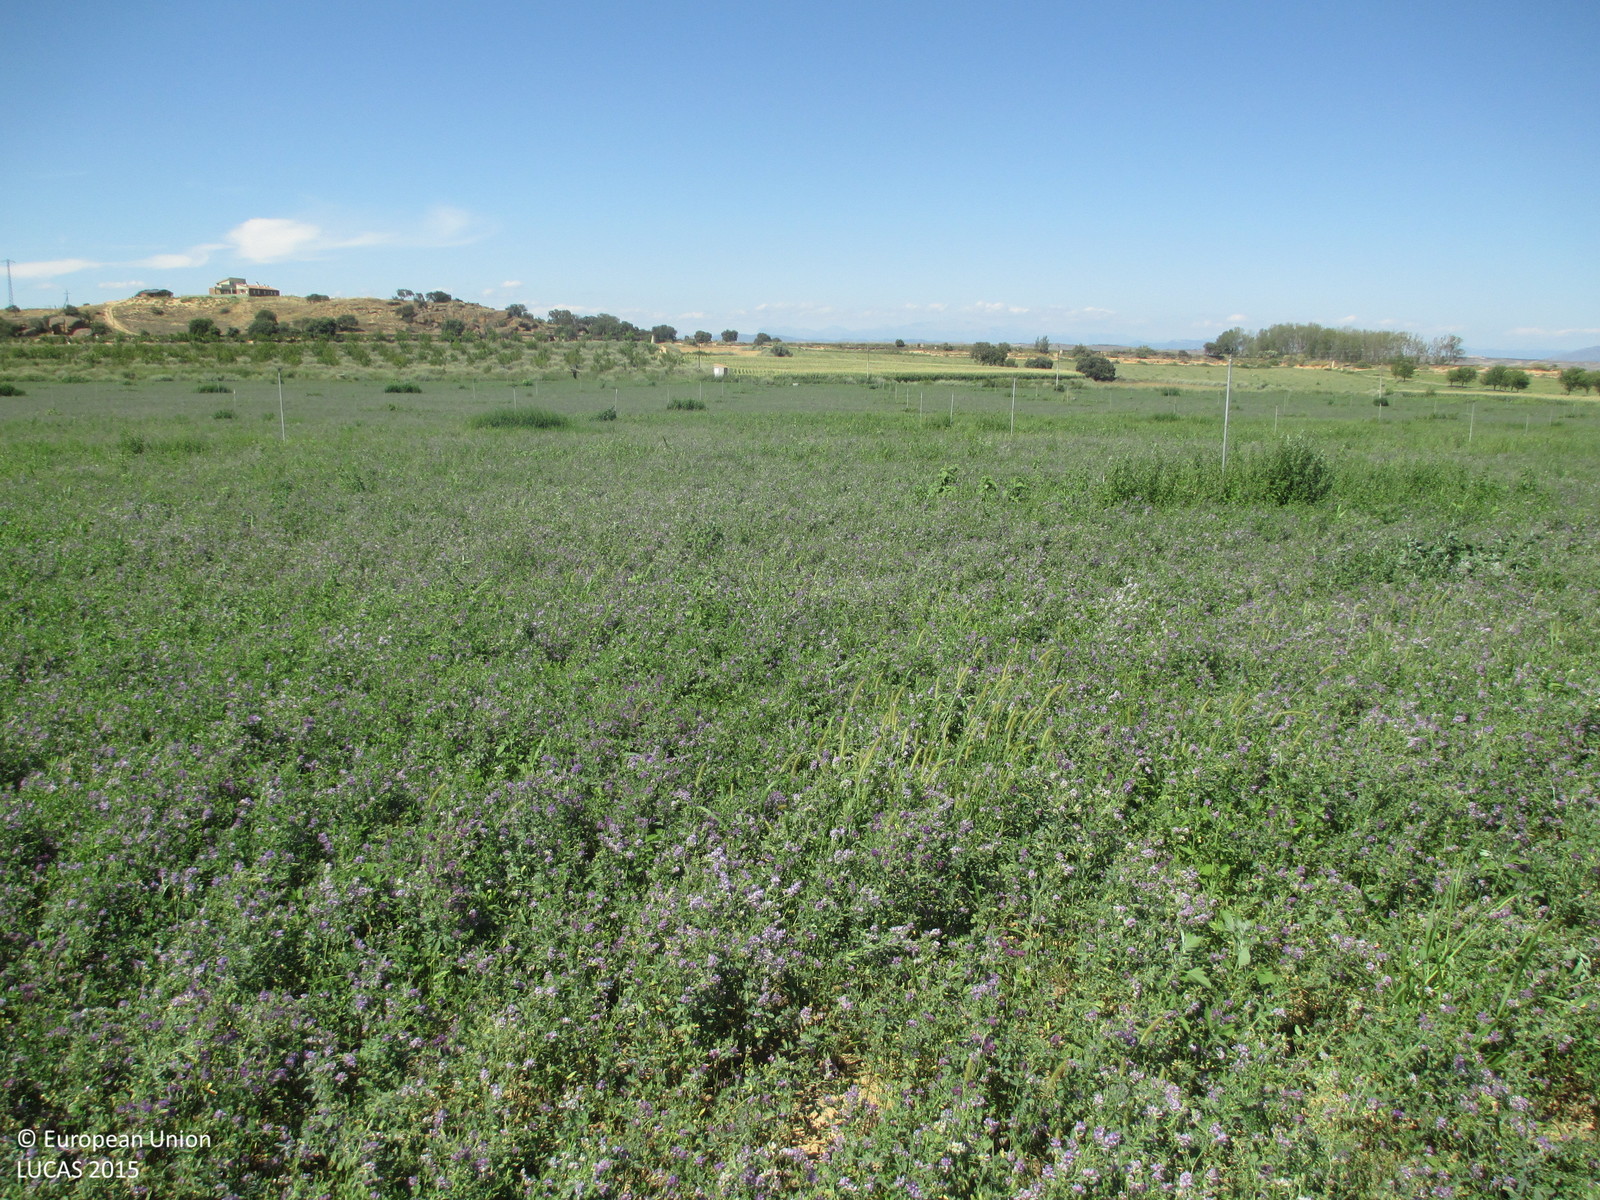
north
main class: Cropland
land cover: Lucerne
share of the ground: > 75 %
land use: Agriculture (excluding fallow land and kitchen gardens)
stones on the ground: < 10 %
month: July
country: ES
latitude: 41.9273
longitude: 0.0576
